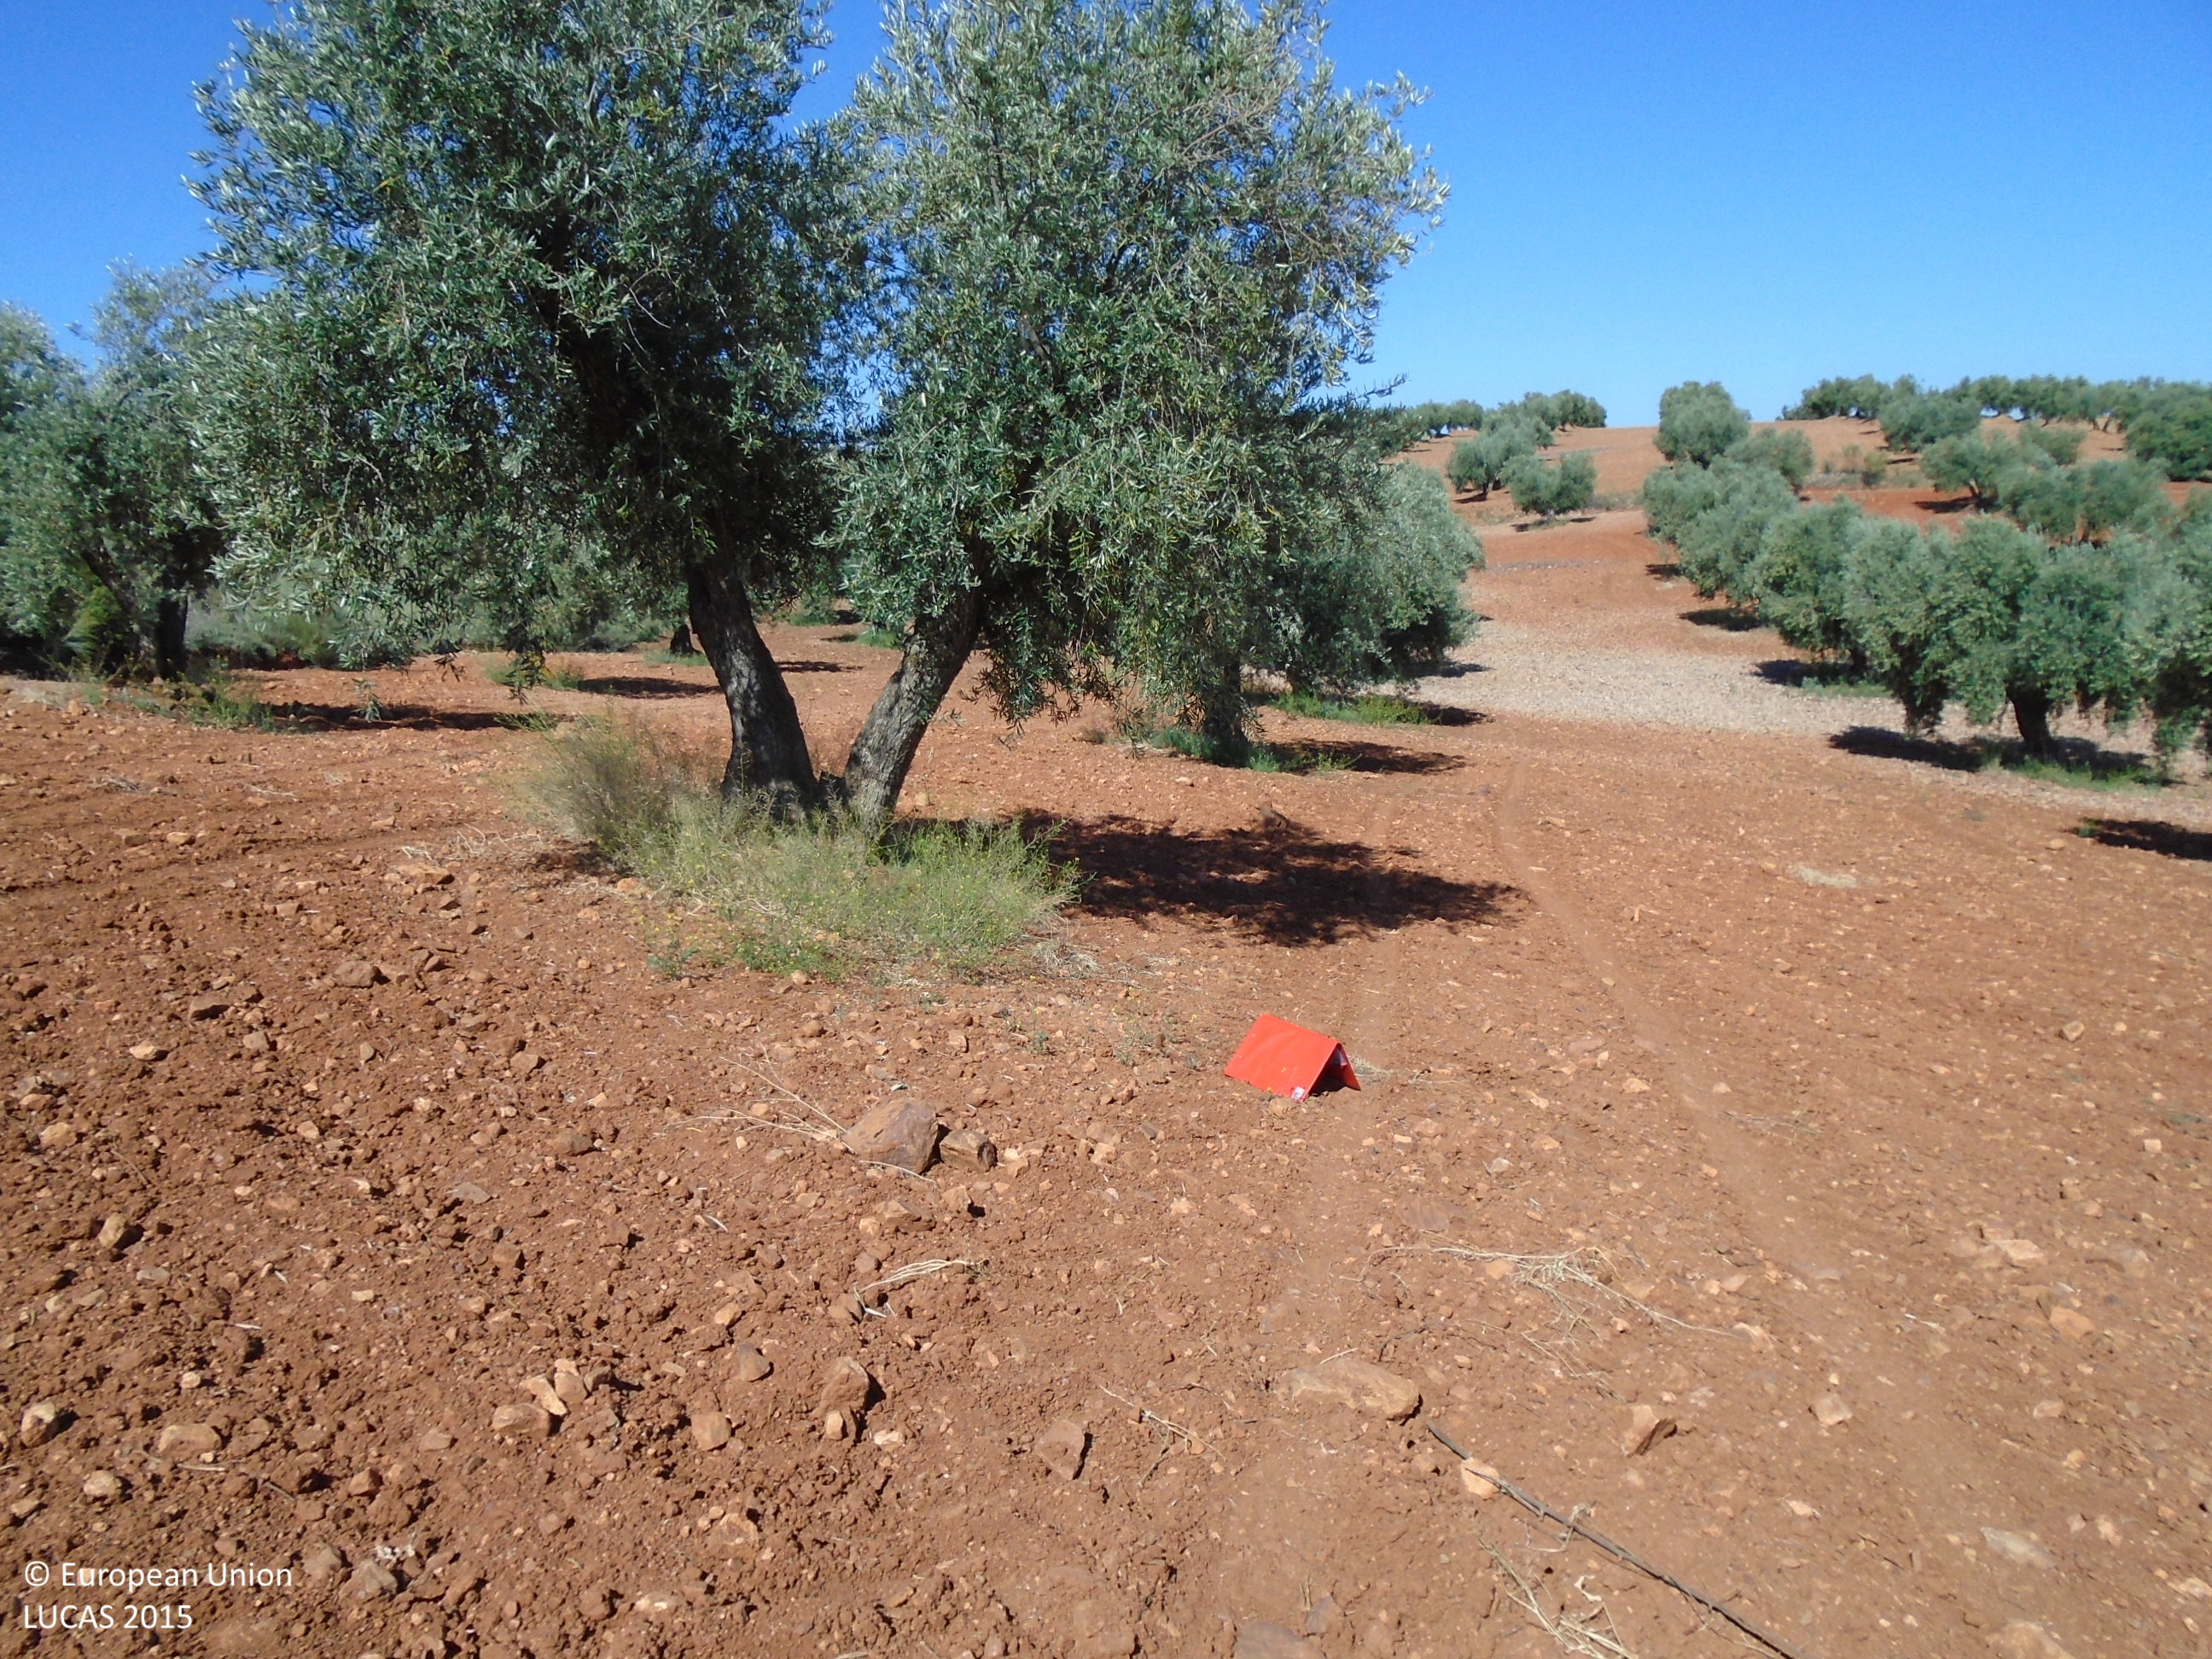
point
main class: Cropland
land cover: Olive groves
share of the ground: 10 - 25 %
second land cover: Other bare soil
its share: > 75 %
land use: Agriculture (excluding fallow land and kitchen gardens)
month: May
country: ES
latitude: 39.7064
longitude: -3.6857
